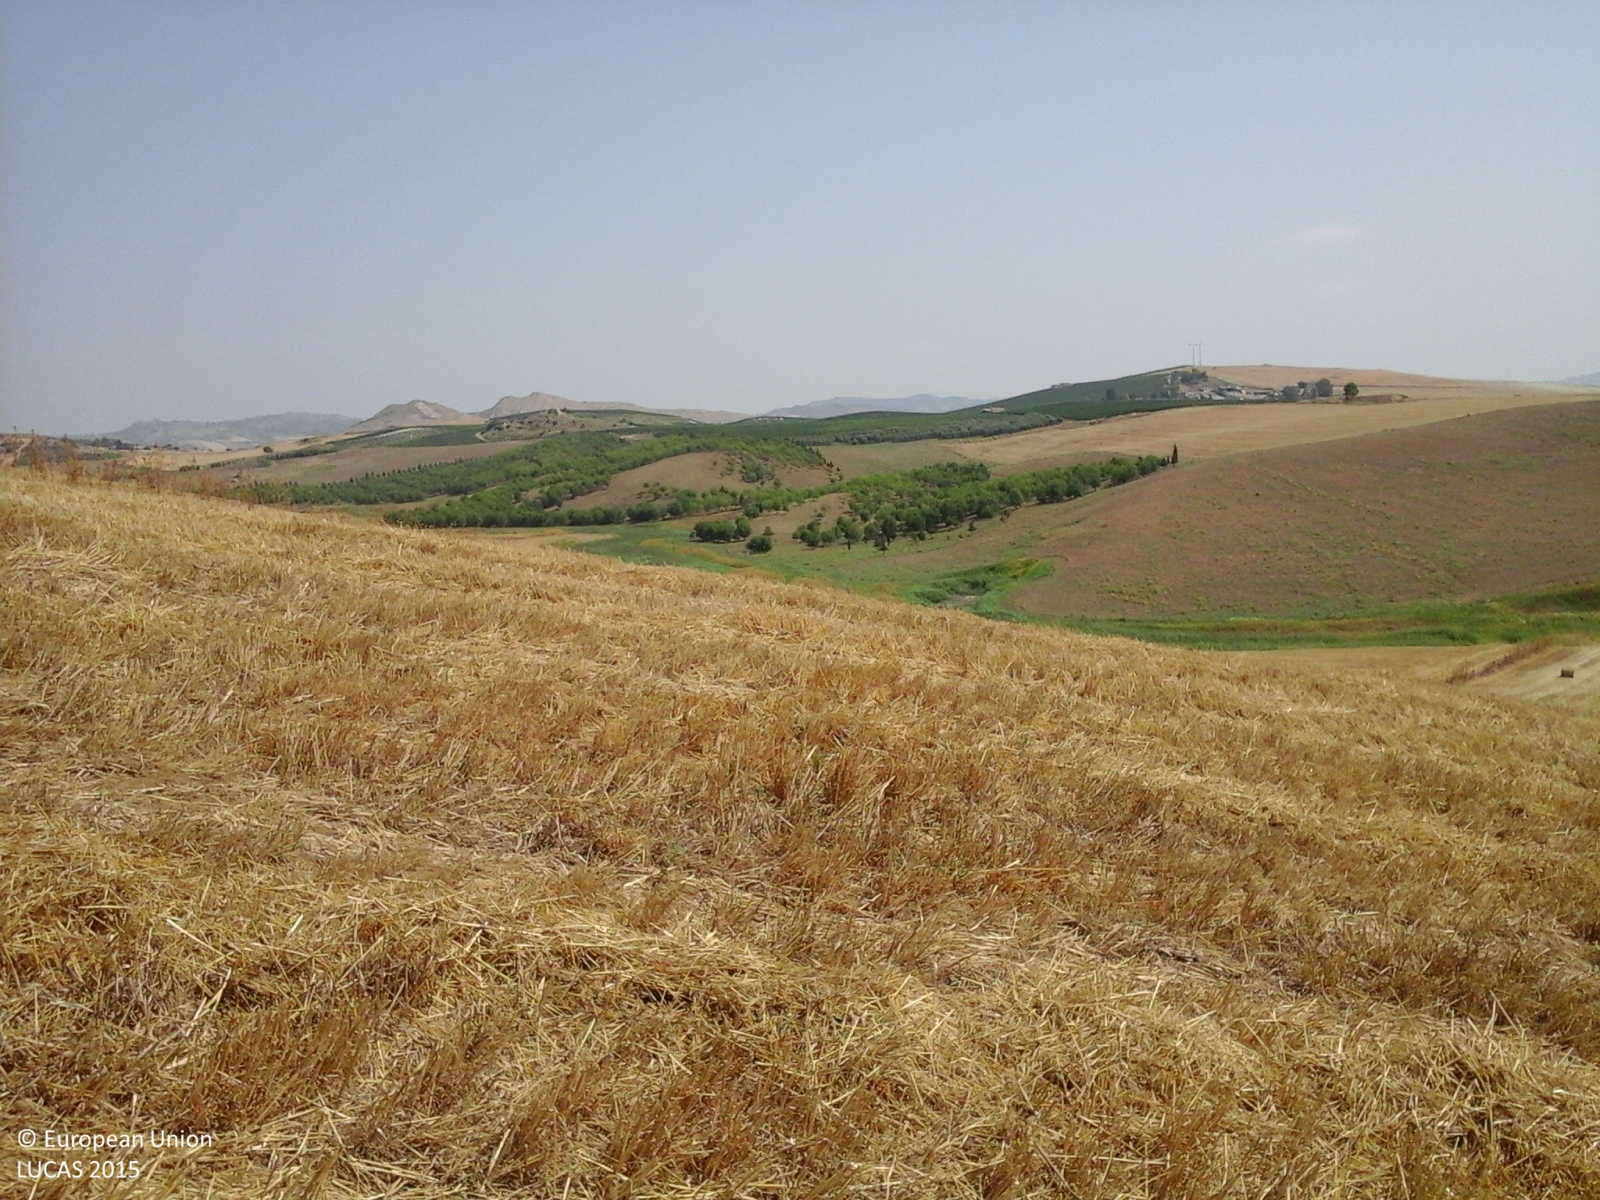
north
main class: Cropland
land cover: Durum wheat
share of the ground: > 75 %
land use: Agriculture (excluding fallow land and kitchen gardens)
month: July
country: IT
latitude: 37.3916
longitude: 13.9795
